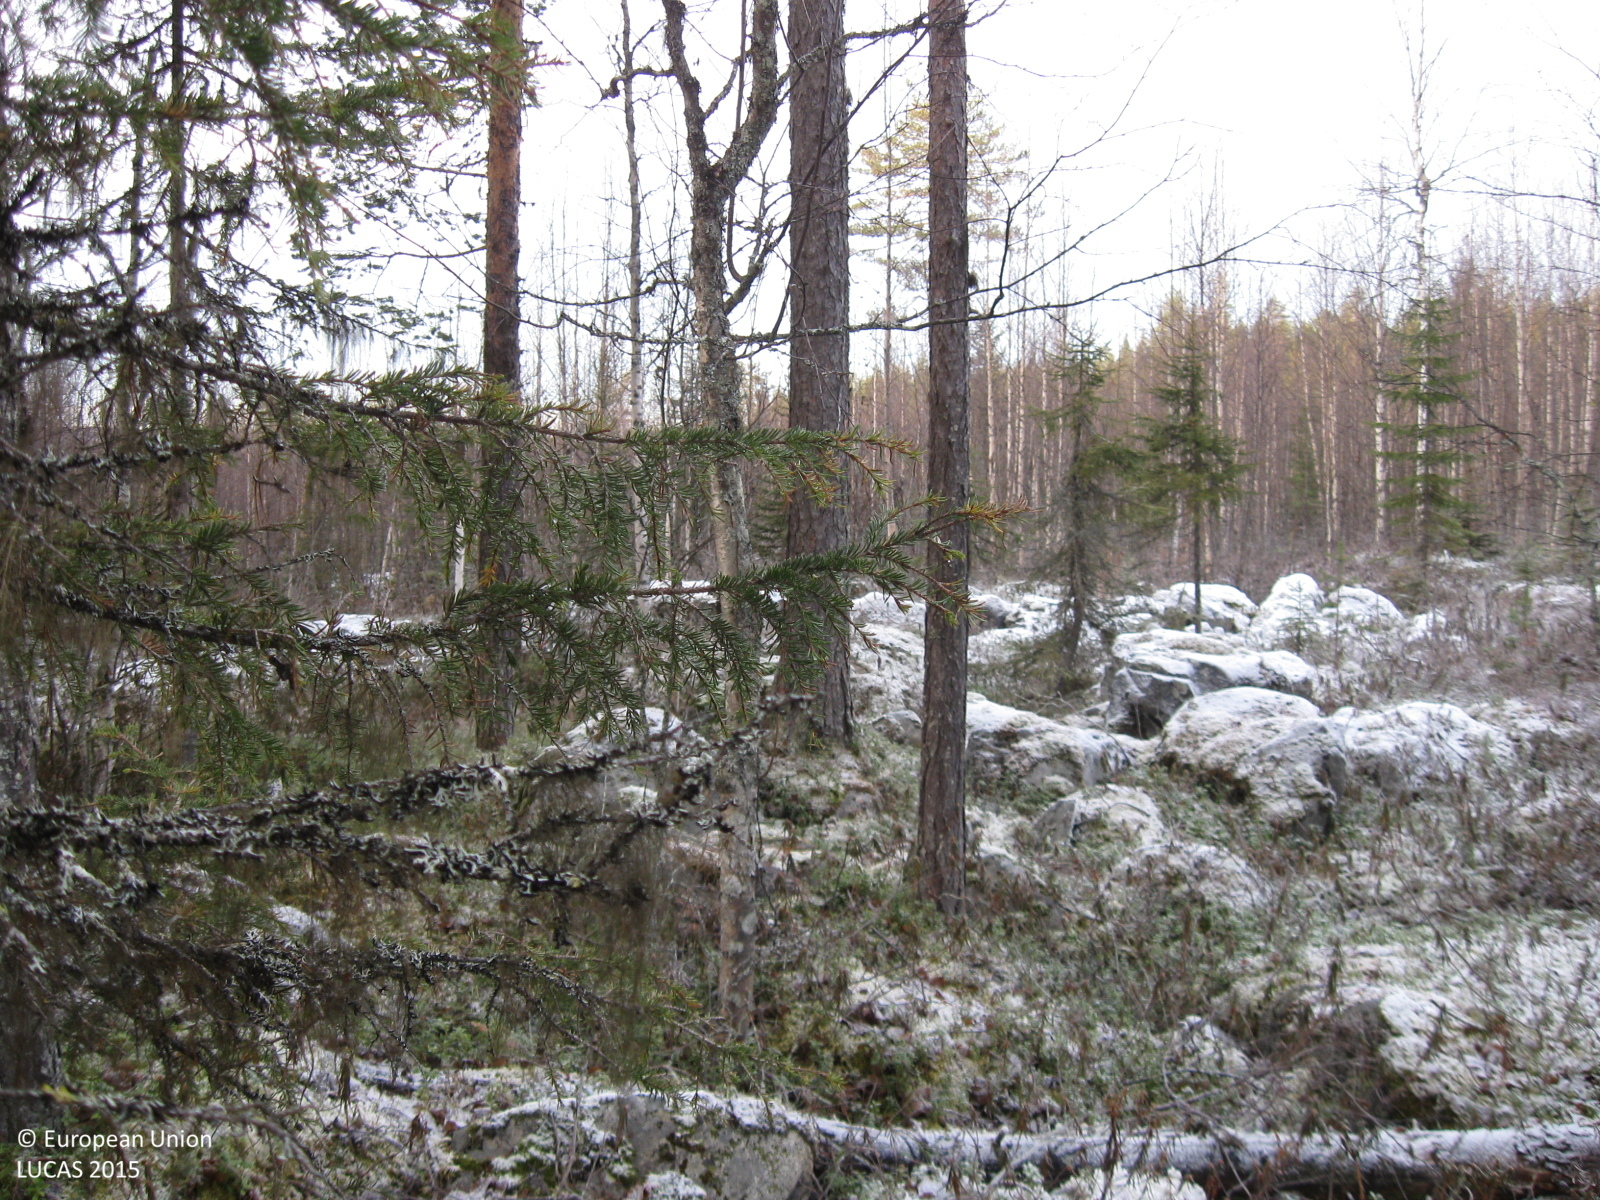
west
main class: Woodland
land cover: Pine dominated mixed woodland
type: boreal forest
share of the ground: 50 - 75 %
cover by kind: coniferous forest trees 45 %, broadleaved forest trees 25 %, unconsolidated bare surface 15 %, shrubs 5 %, herbaceous plants 5 %, lichens and mosses 5 %
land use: Forestry
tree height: > 5 m
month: October
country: SE
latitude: 66.2213
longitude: 21.6357
